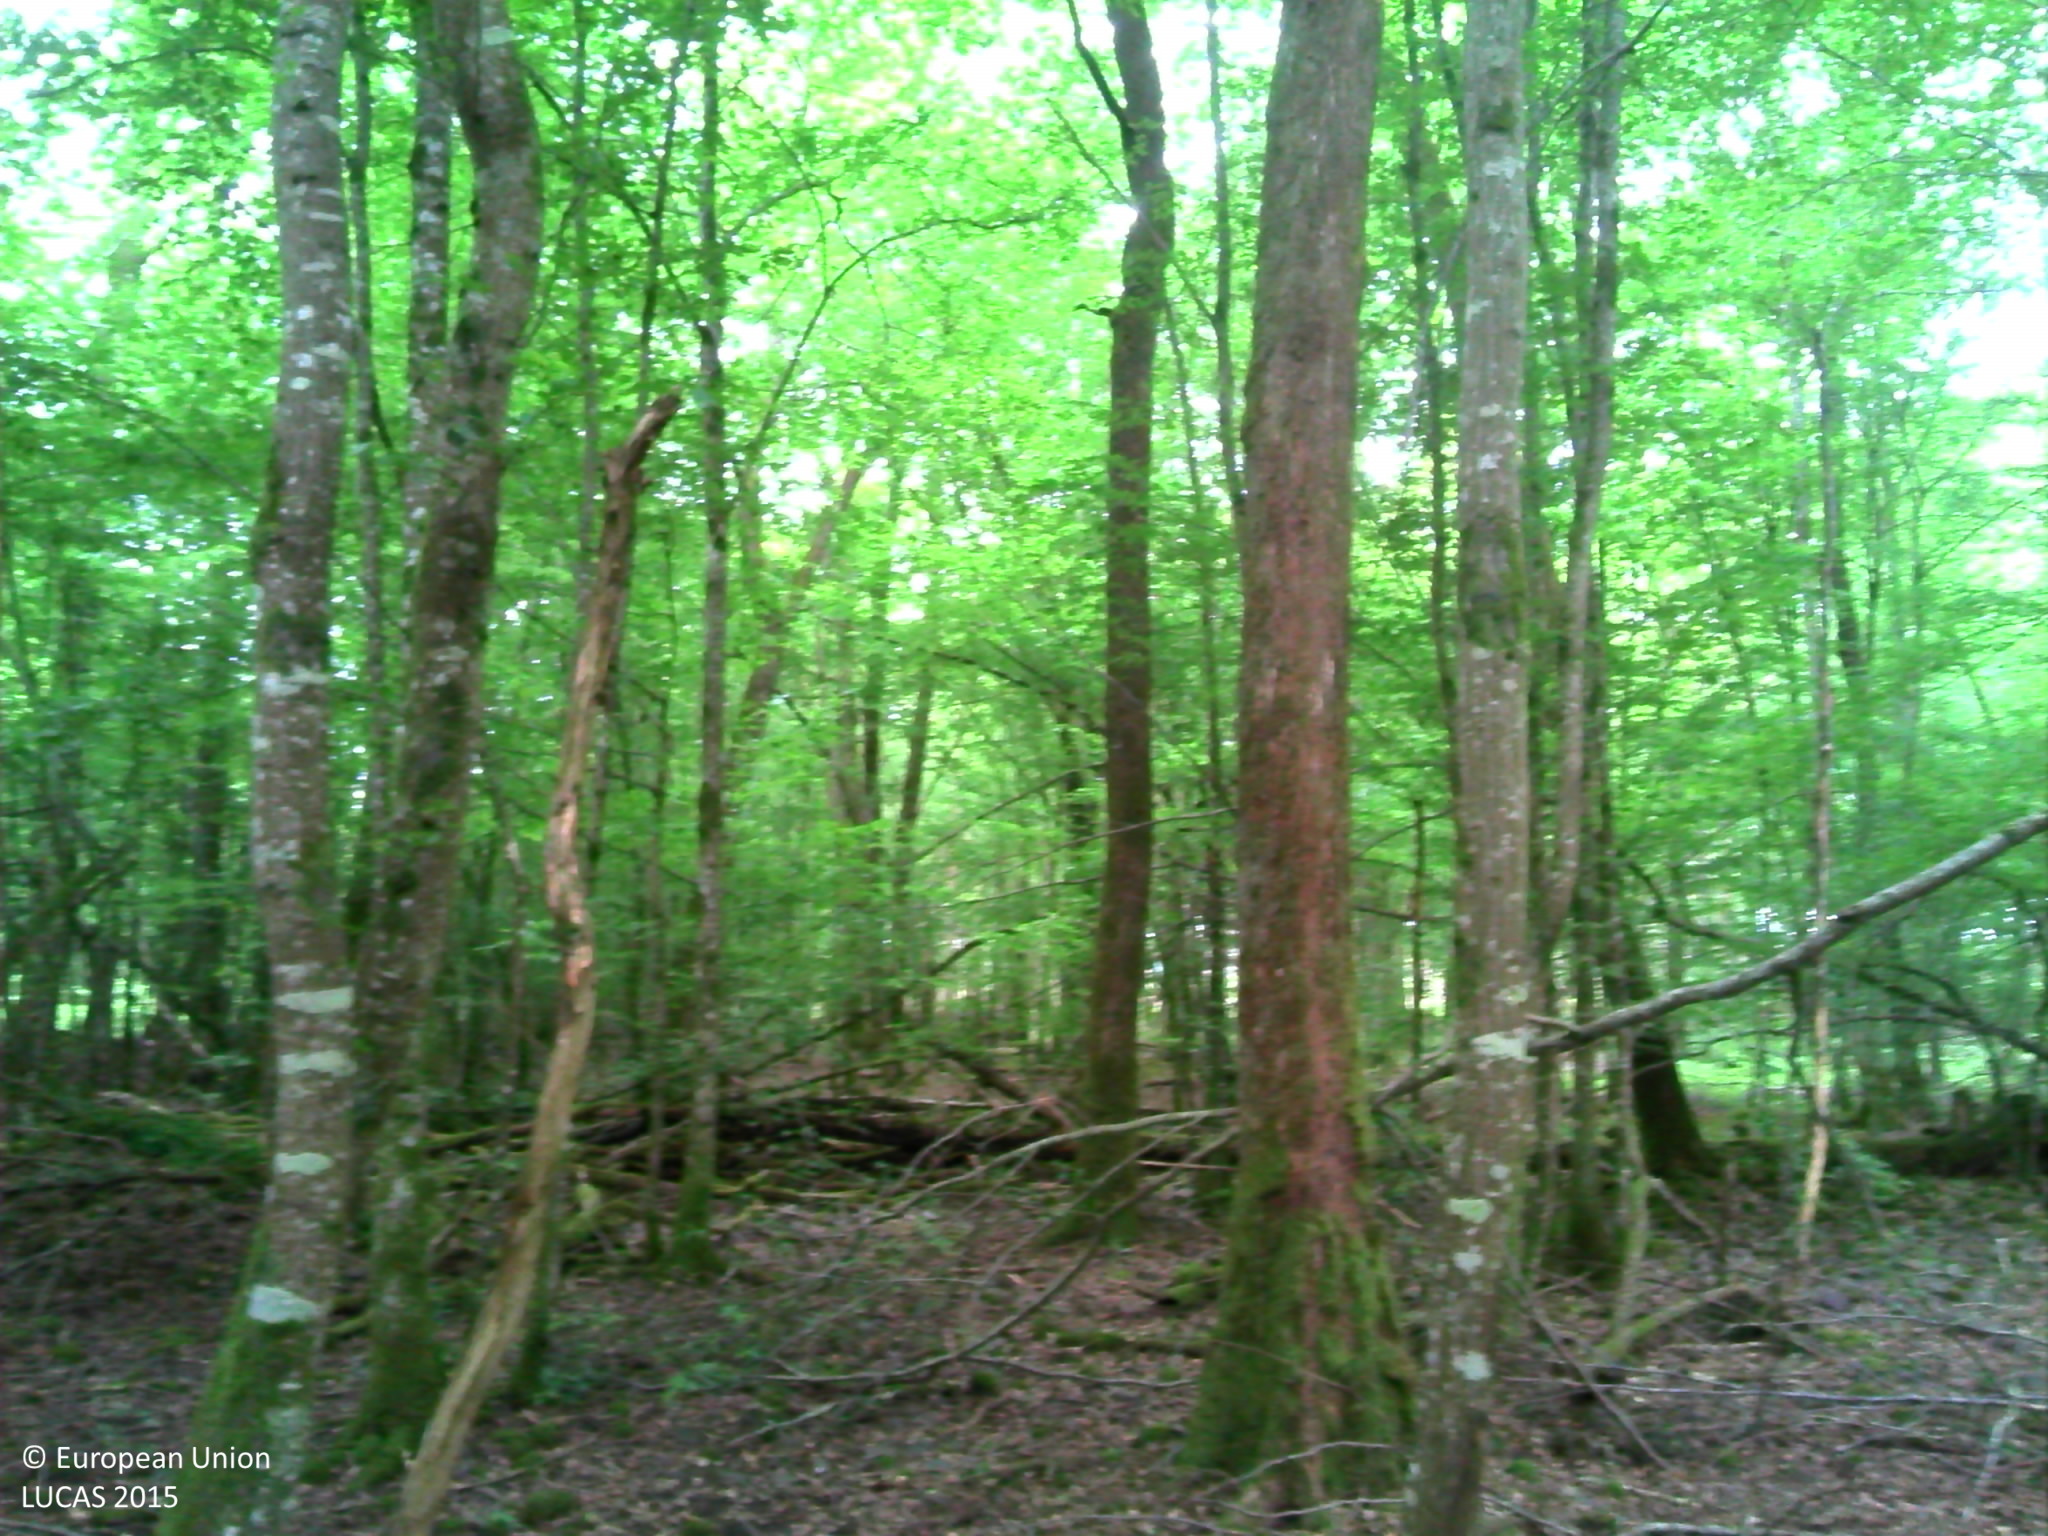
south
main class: Woodland
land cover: Broadleaved woodland
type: mesophytic deciduous forest
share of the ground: > 75 %
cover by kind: broadleaved forest trees 95 %, herbaceous plants 5 %
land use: Forestry
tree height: > 5 m
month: June
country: FR
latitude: 47.1810
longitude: 3.1737
